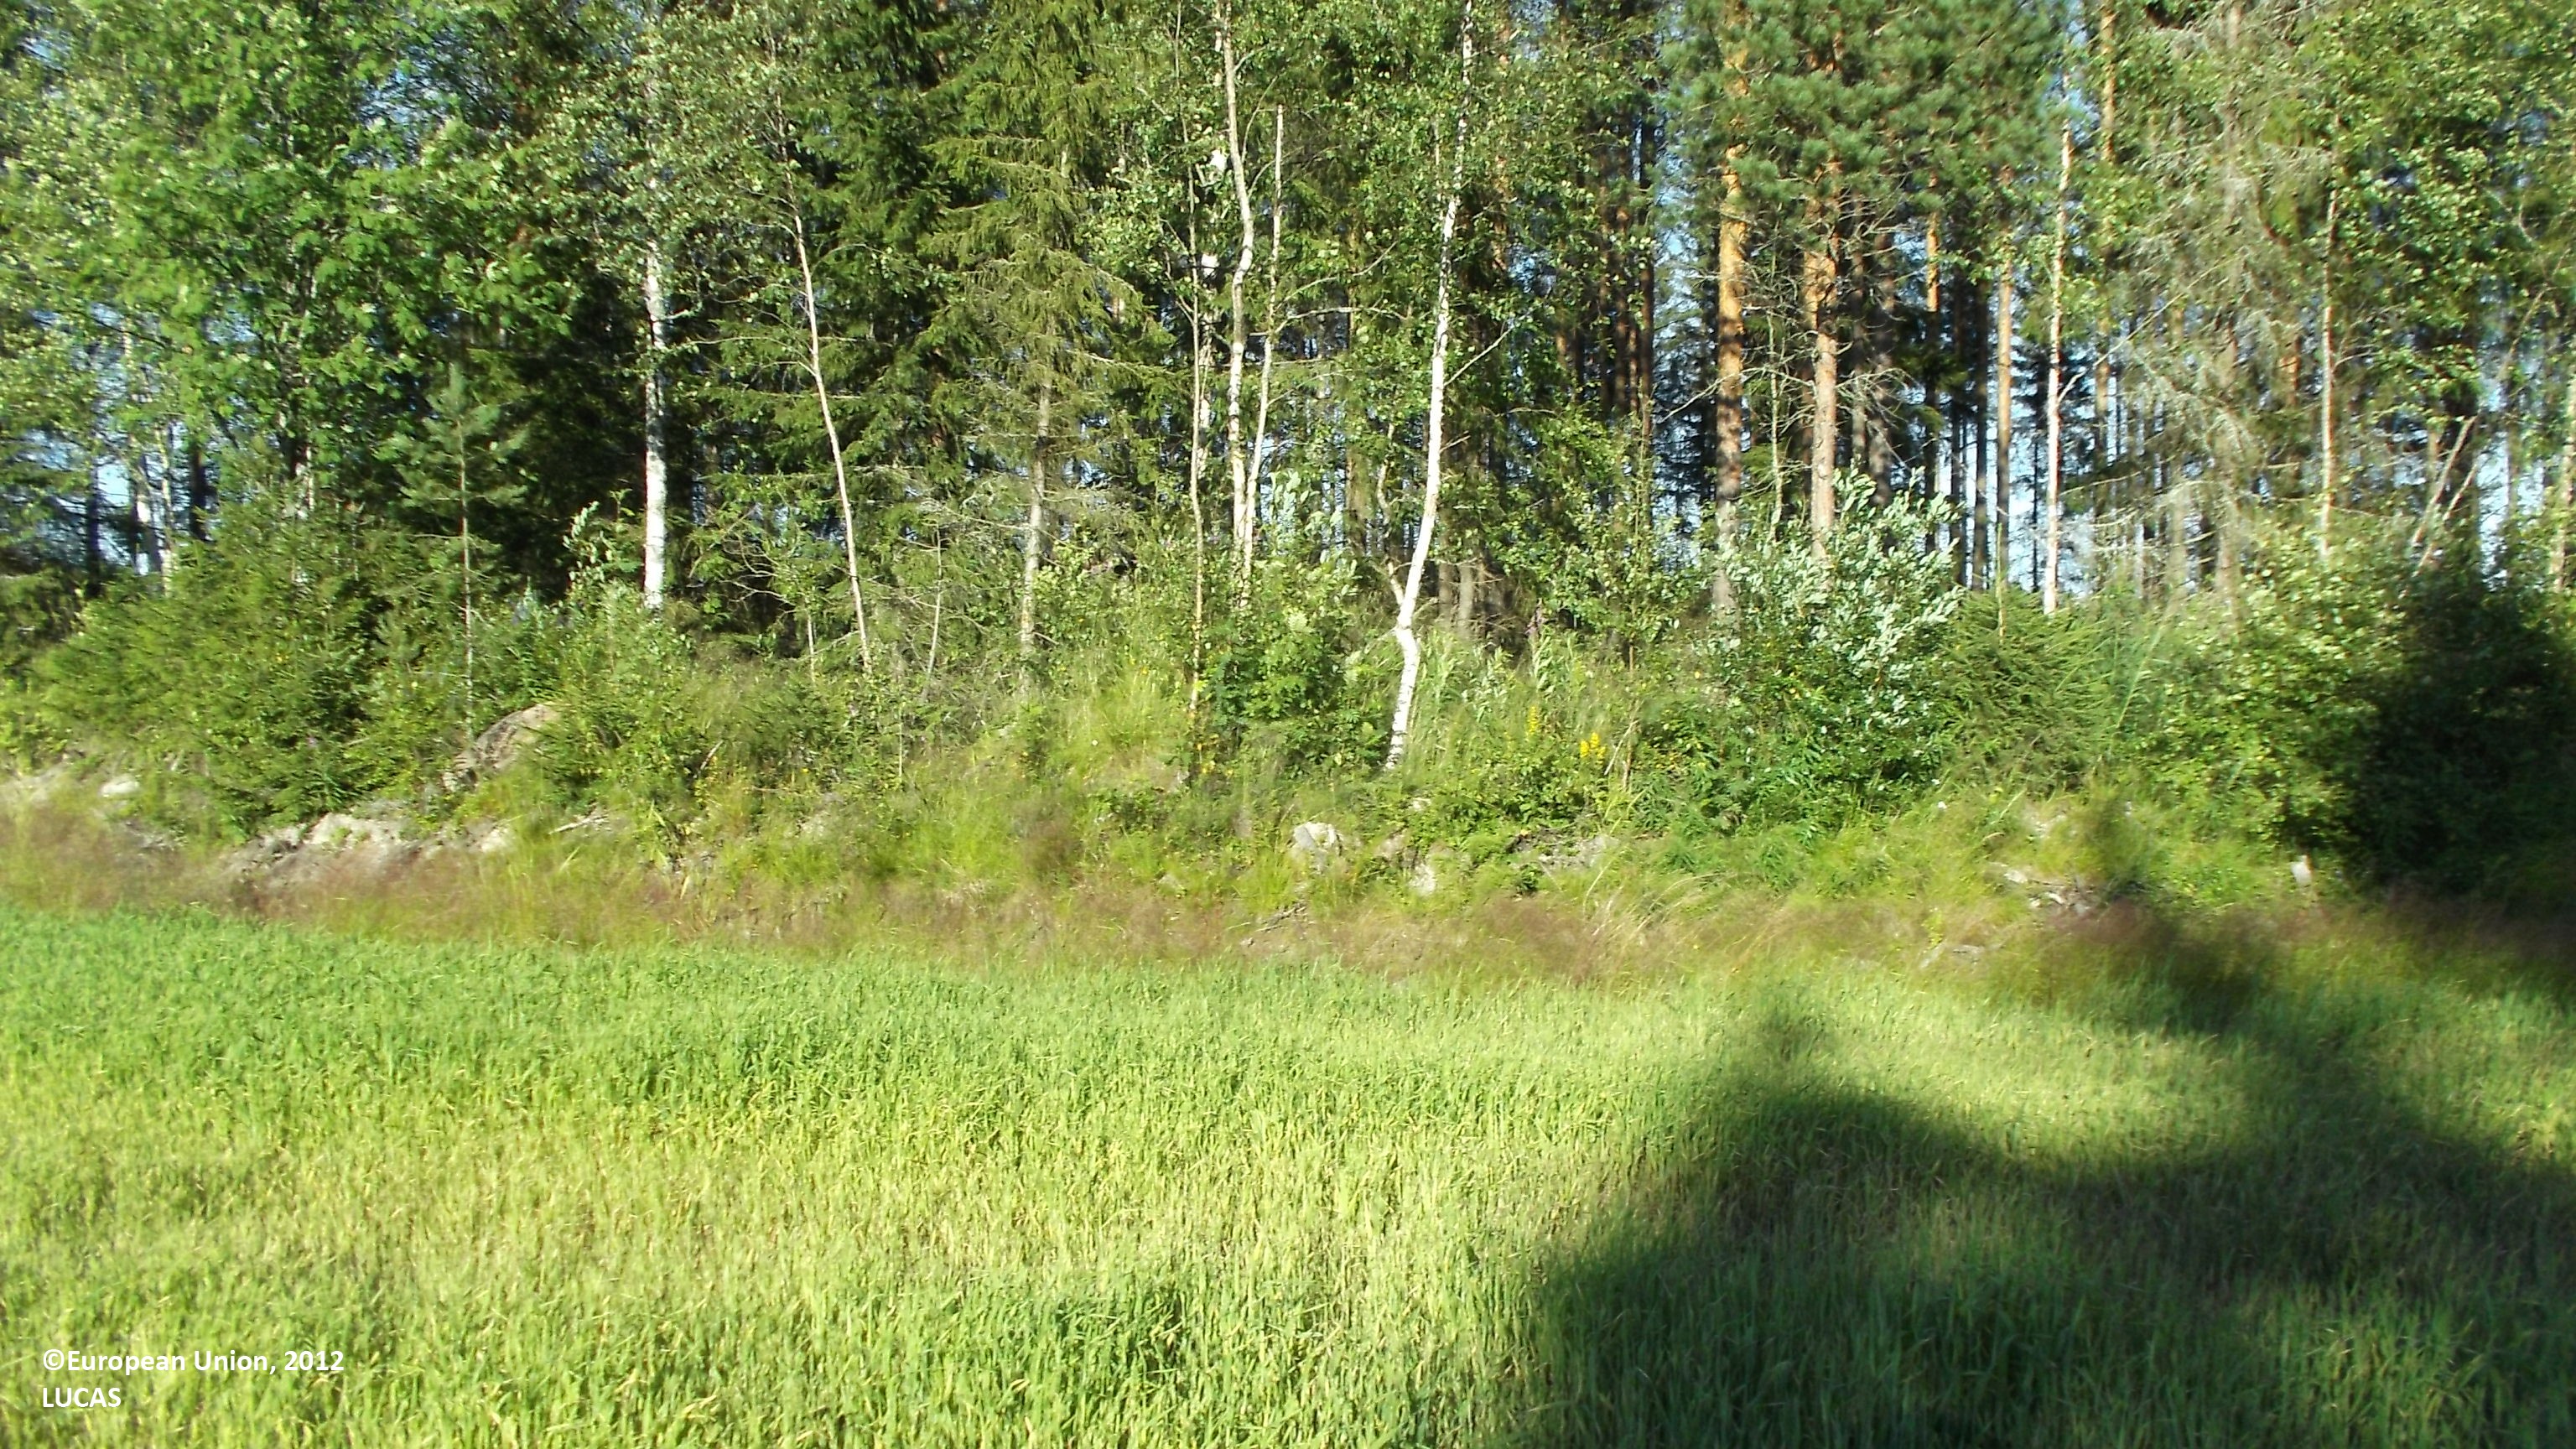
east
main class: Cropland
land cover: Barley
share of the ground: > 75 %
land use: Agriculture (excluding fallow land and kitchen gardens)
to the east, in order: Barley; Ditches and canals; Other mixed woodland; Tracks; Pine dominated mixed woodland; Tracks; Pine dominated coniferous woodland; Tracks; Spruce dominated mixed woodland; Spontaneously vegetated surfaces; Ditches and canals; Spontaneously vegetated surfaces; Ditches and canals; Spontaneously vegetated surfaces; Paved roads, cycling and walking lanes; Spontaneously vegetated surfaces; Ditches and canals; Spontaneously vegetated surfaces; Tracks; Barley
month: July
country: FI
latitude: 63.6832
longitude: 22.9299
